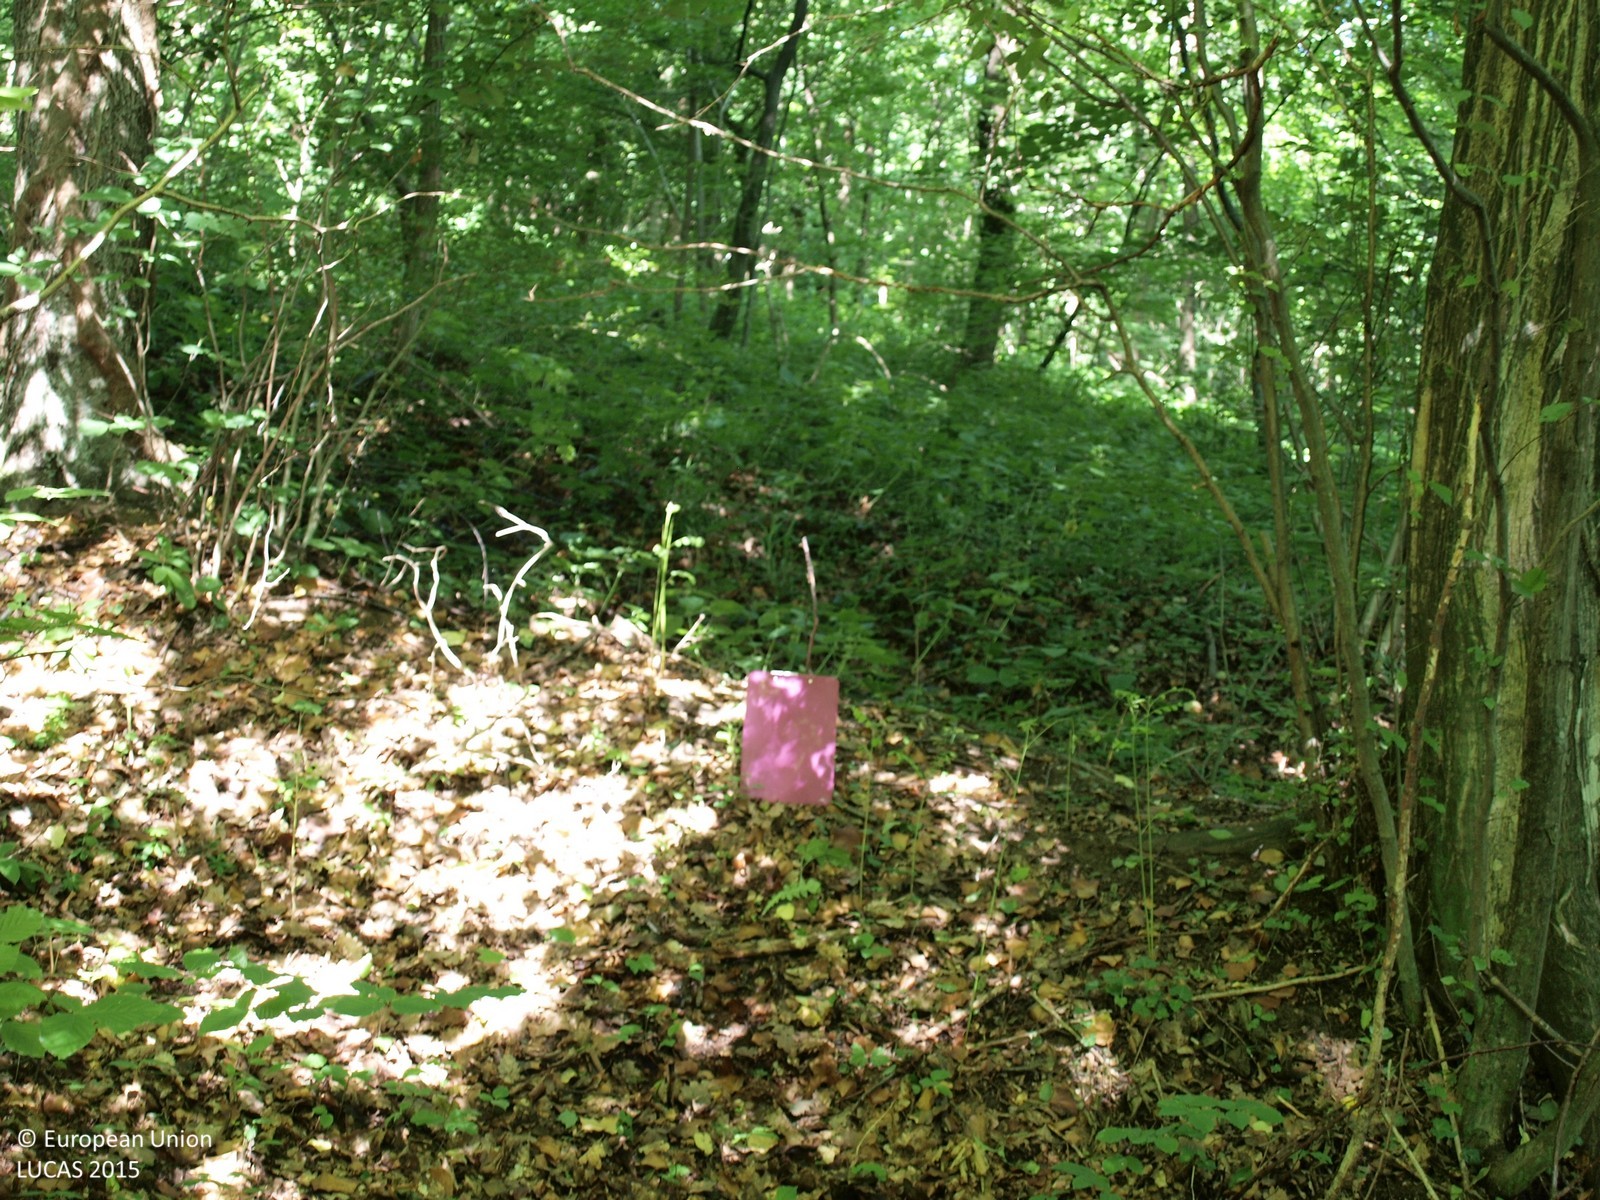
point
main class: Woodland
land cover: Broadleaved woodland
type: mesophytic deciduous forest
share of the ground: > 75 %
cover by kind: broadleaved forest trees 100 %
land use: Forestry
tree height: > 5 m
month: June
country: HR
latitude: 46.1778
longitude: 15.7629
